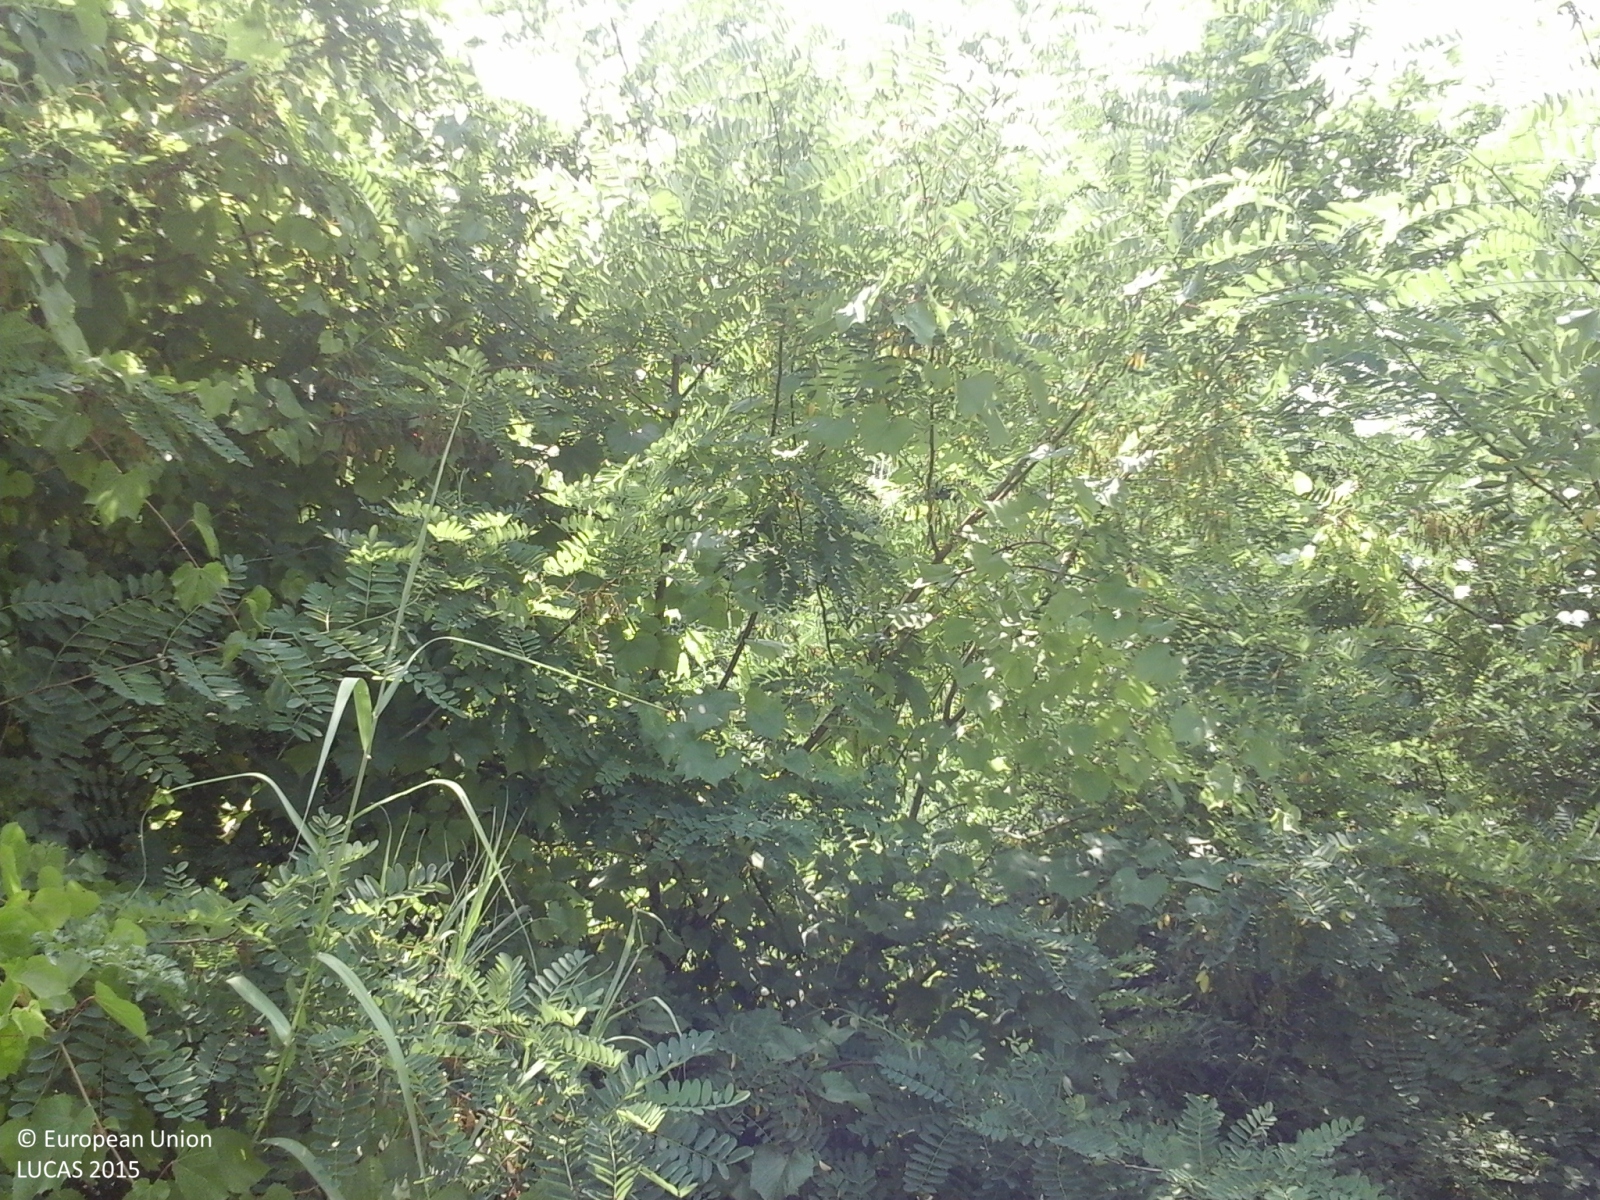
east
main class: Shrubland
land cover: Shrubland with sparse tree cover
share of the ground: 50 - 75 %
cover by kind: shrubs 90 %, broadleaved forest trees 5 %, herbaceous plants 5 %
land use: Abandoned areas
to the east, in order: Shrubland with sparse tree cover; Vineyards; Lines of trees; Vineyards; Olive groves; Vineyards; Olive groves; Spontaneously vegetated surfaces; Olive groves; Artificial constructions in urban areas; Olive groves; Electric lines; Grass margins; Ditches and canals; Single bushes/trees; Vineyards
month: July
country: IT
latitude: 42.3479
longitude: 14.2480
